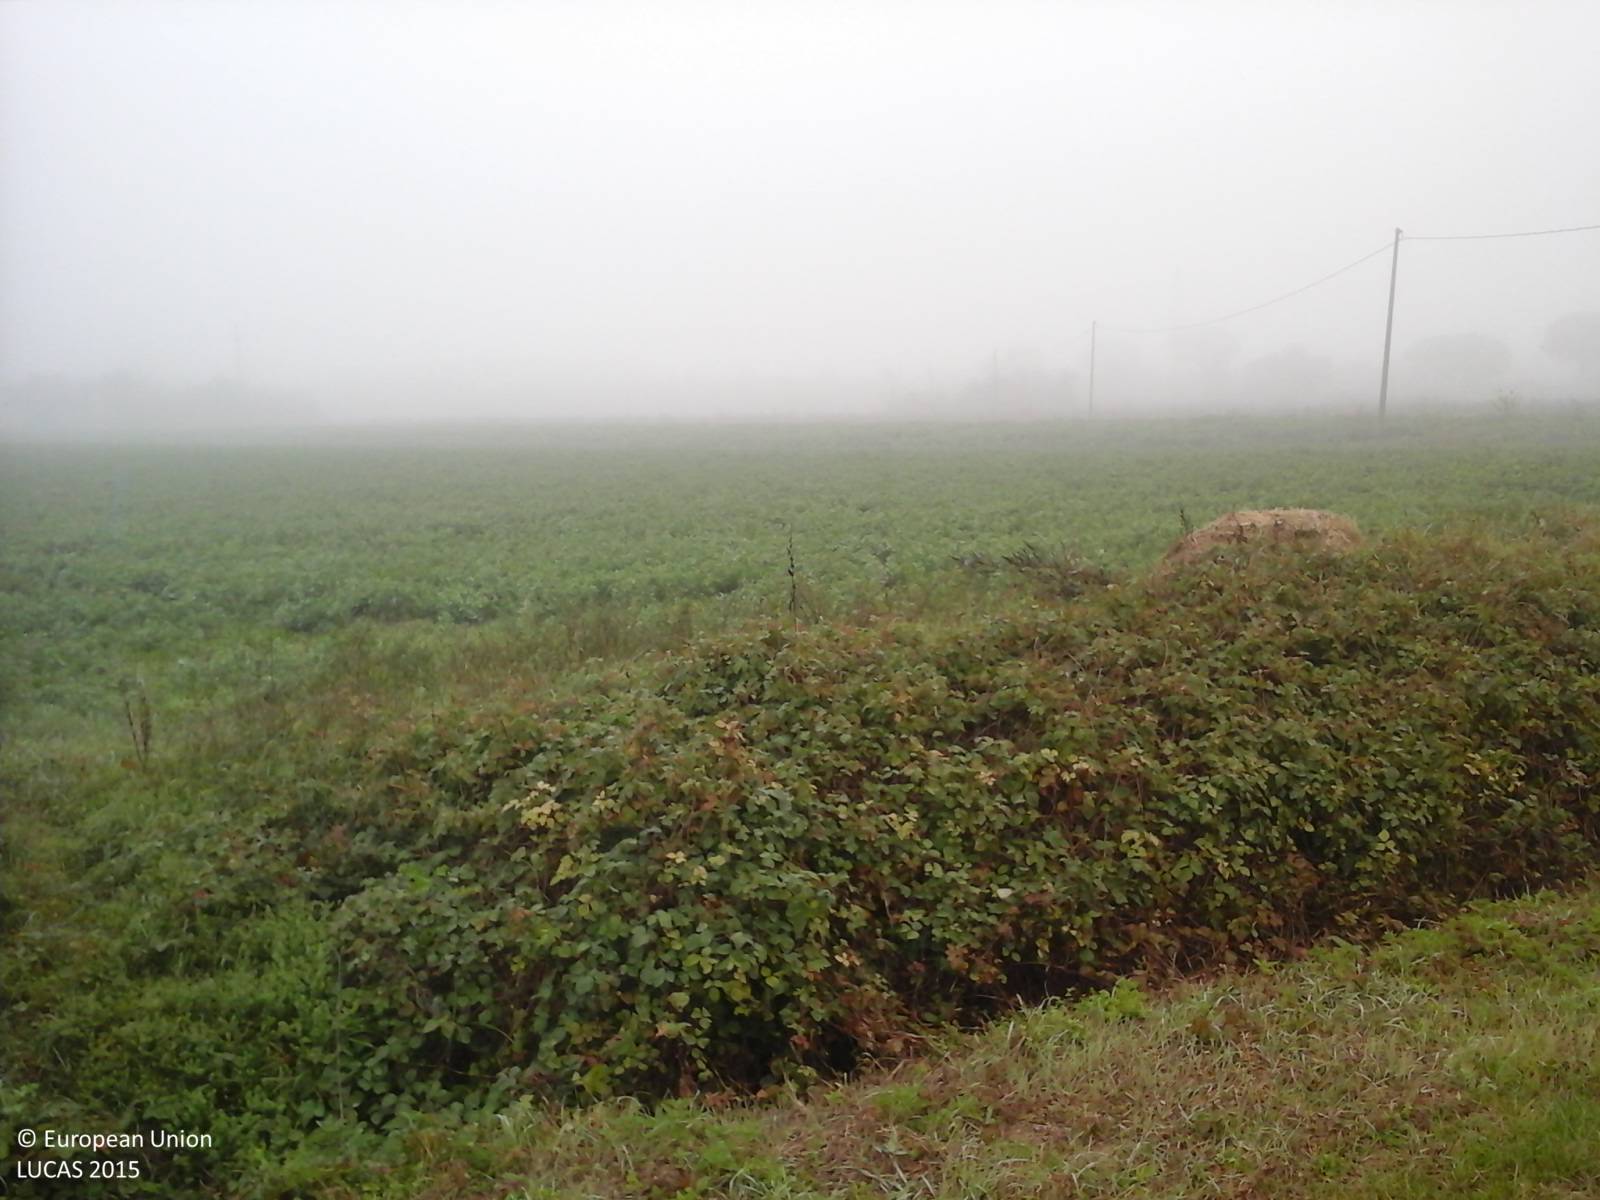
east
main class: Cropland
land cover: Other leguminous and mixtures for fodder
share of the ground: > 75 %
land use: Agriculture (excluding fallow land and kitchen gardens)
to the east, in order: Other leguminous and mixtures for fodder; Electric lines; Other leguminous and mixtures for fodder; Tracks; Ditches and canals; Electric lines; Lucerne; Electric lines; Lucerne; Durum wheat
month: October
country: IT
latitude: 42.8062
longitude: 12.4016
